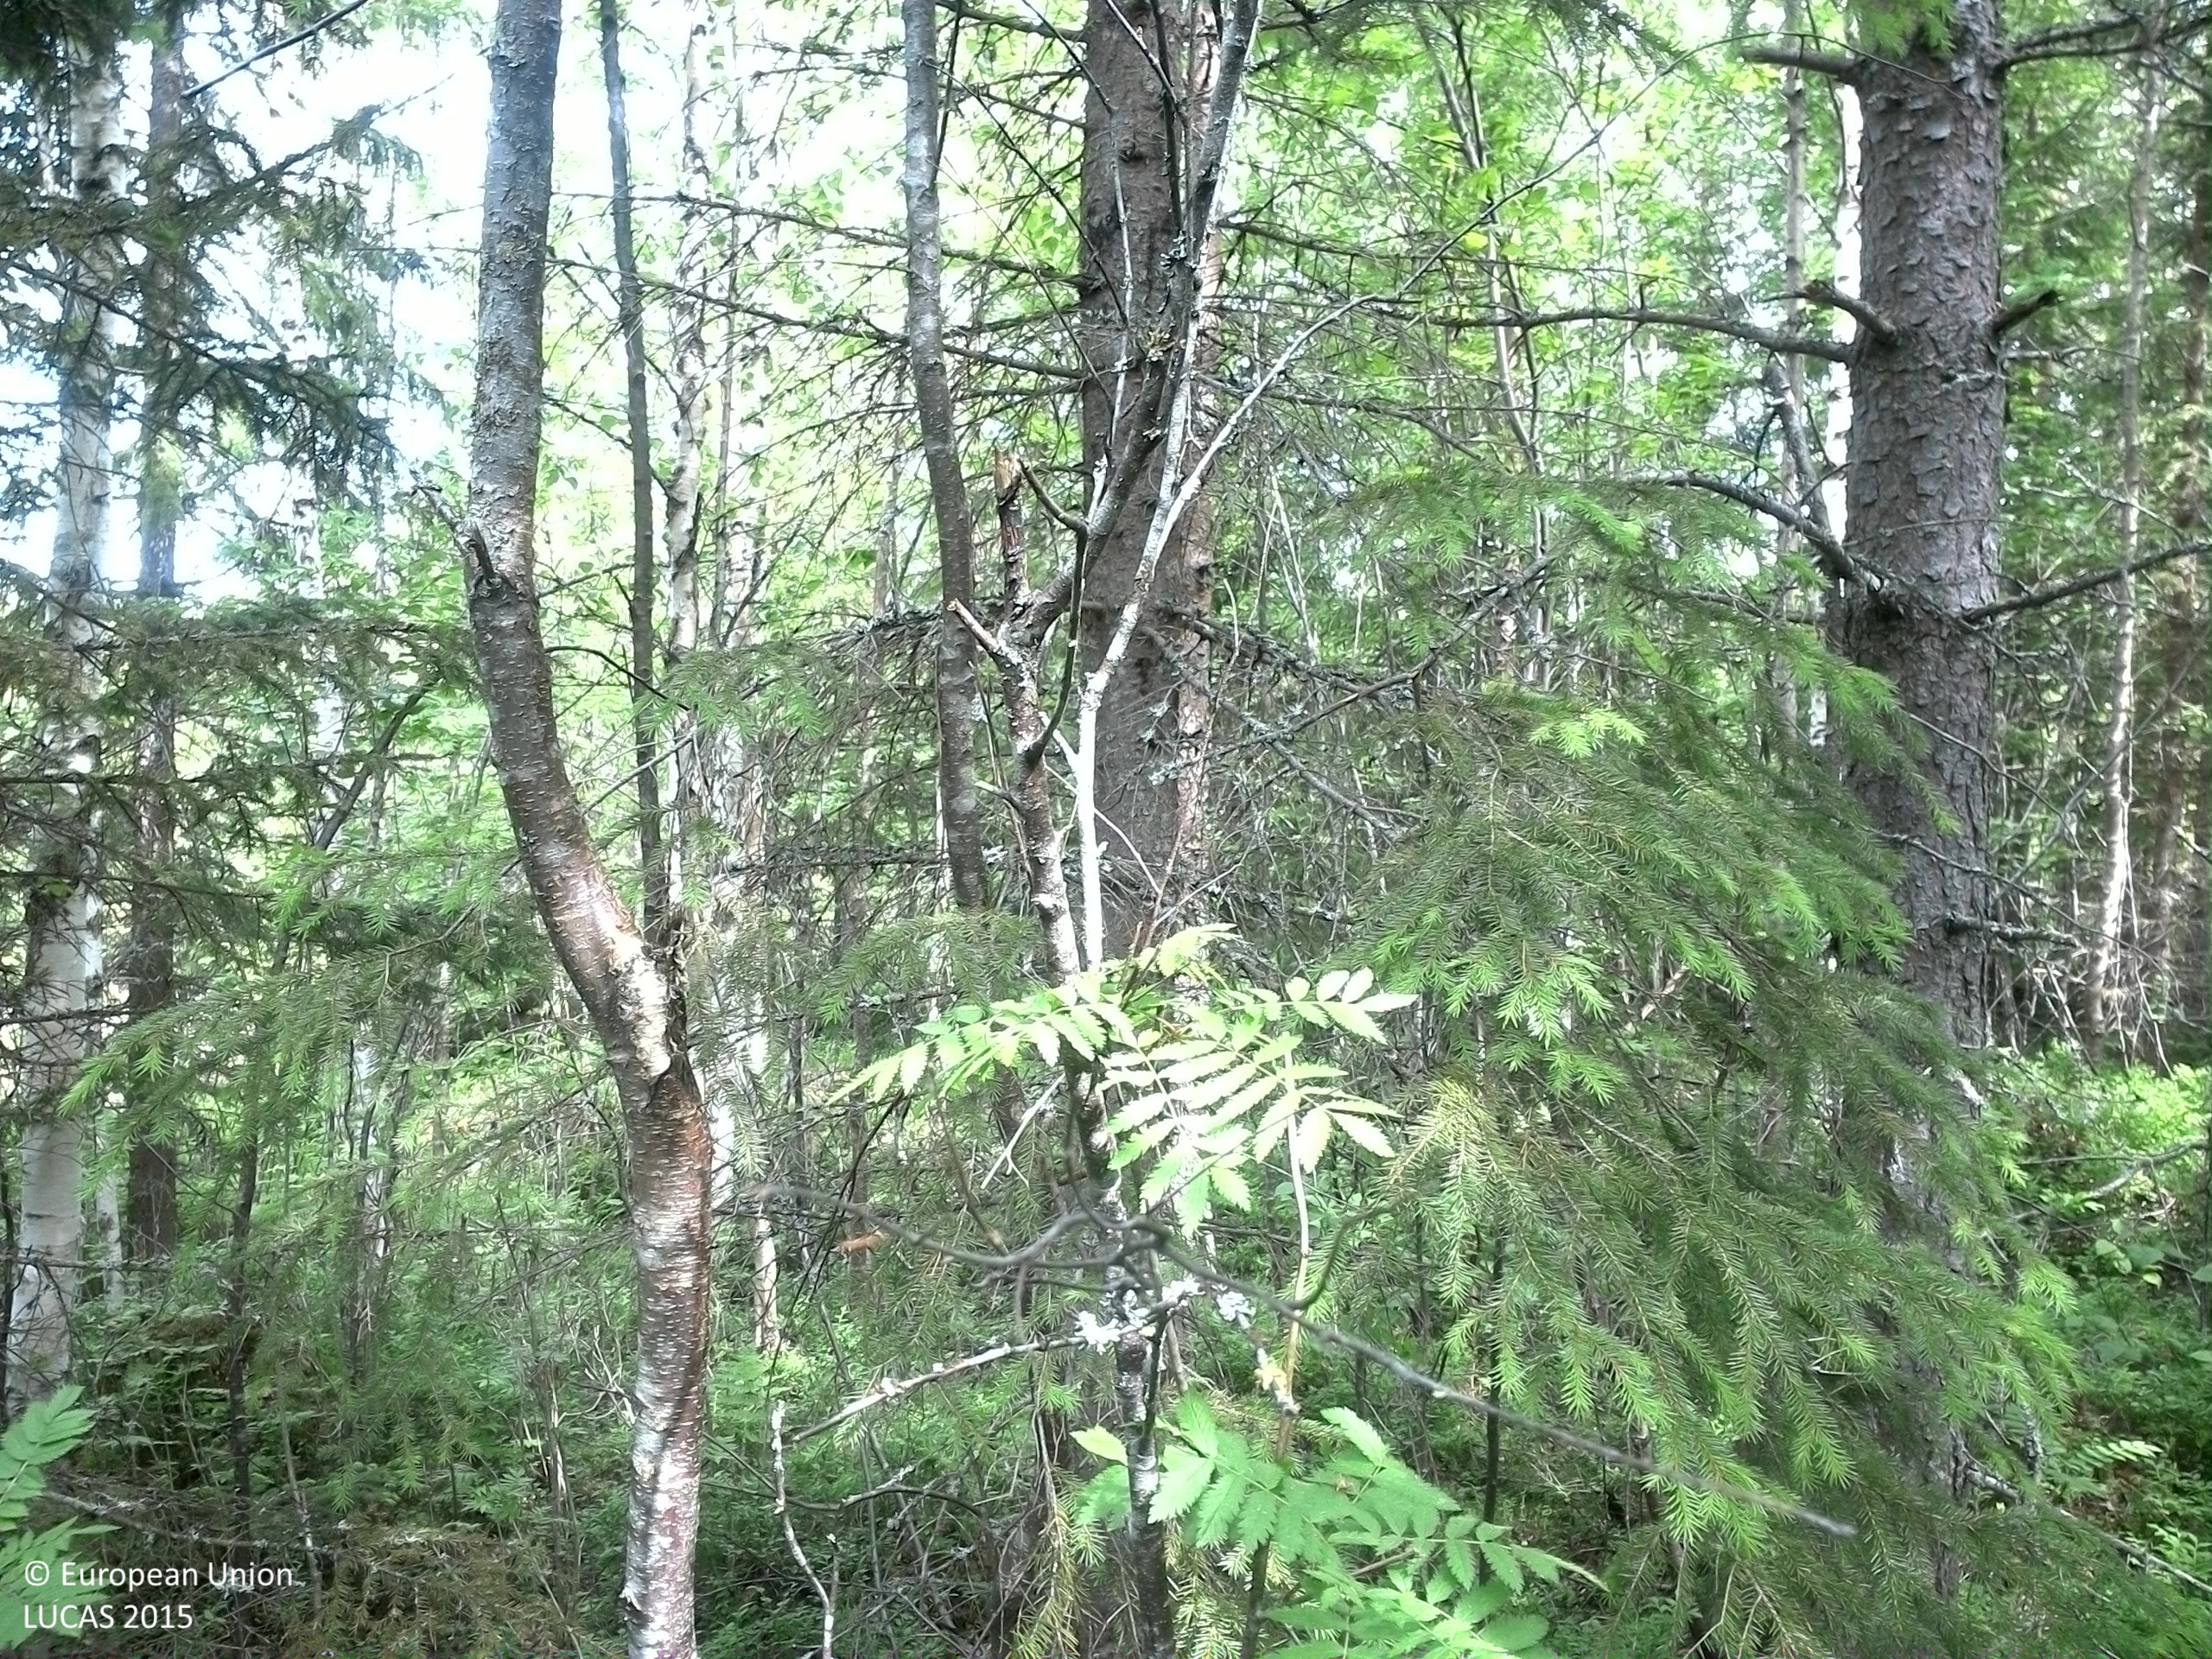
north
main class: Woodland
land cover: Spruce dominated mixed woodland
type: boreal forest
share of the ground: > 75 %
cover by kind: coniferous forest trees 60 %, broadleaved forest trees 20 %, shrubs 20 %
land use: Forestry
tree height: > 5 m
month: June
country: SE
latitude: 62.8683
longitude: 17.7028
